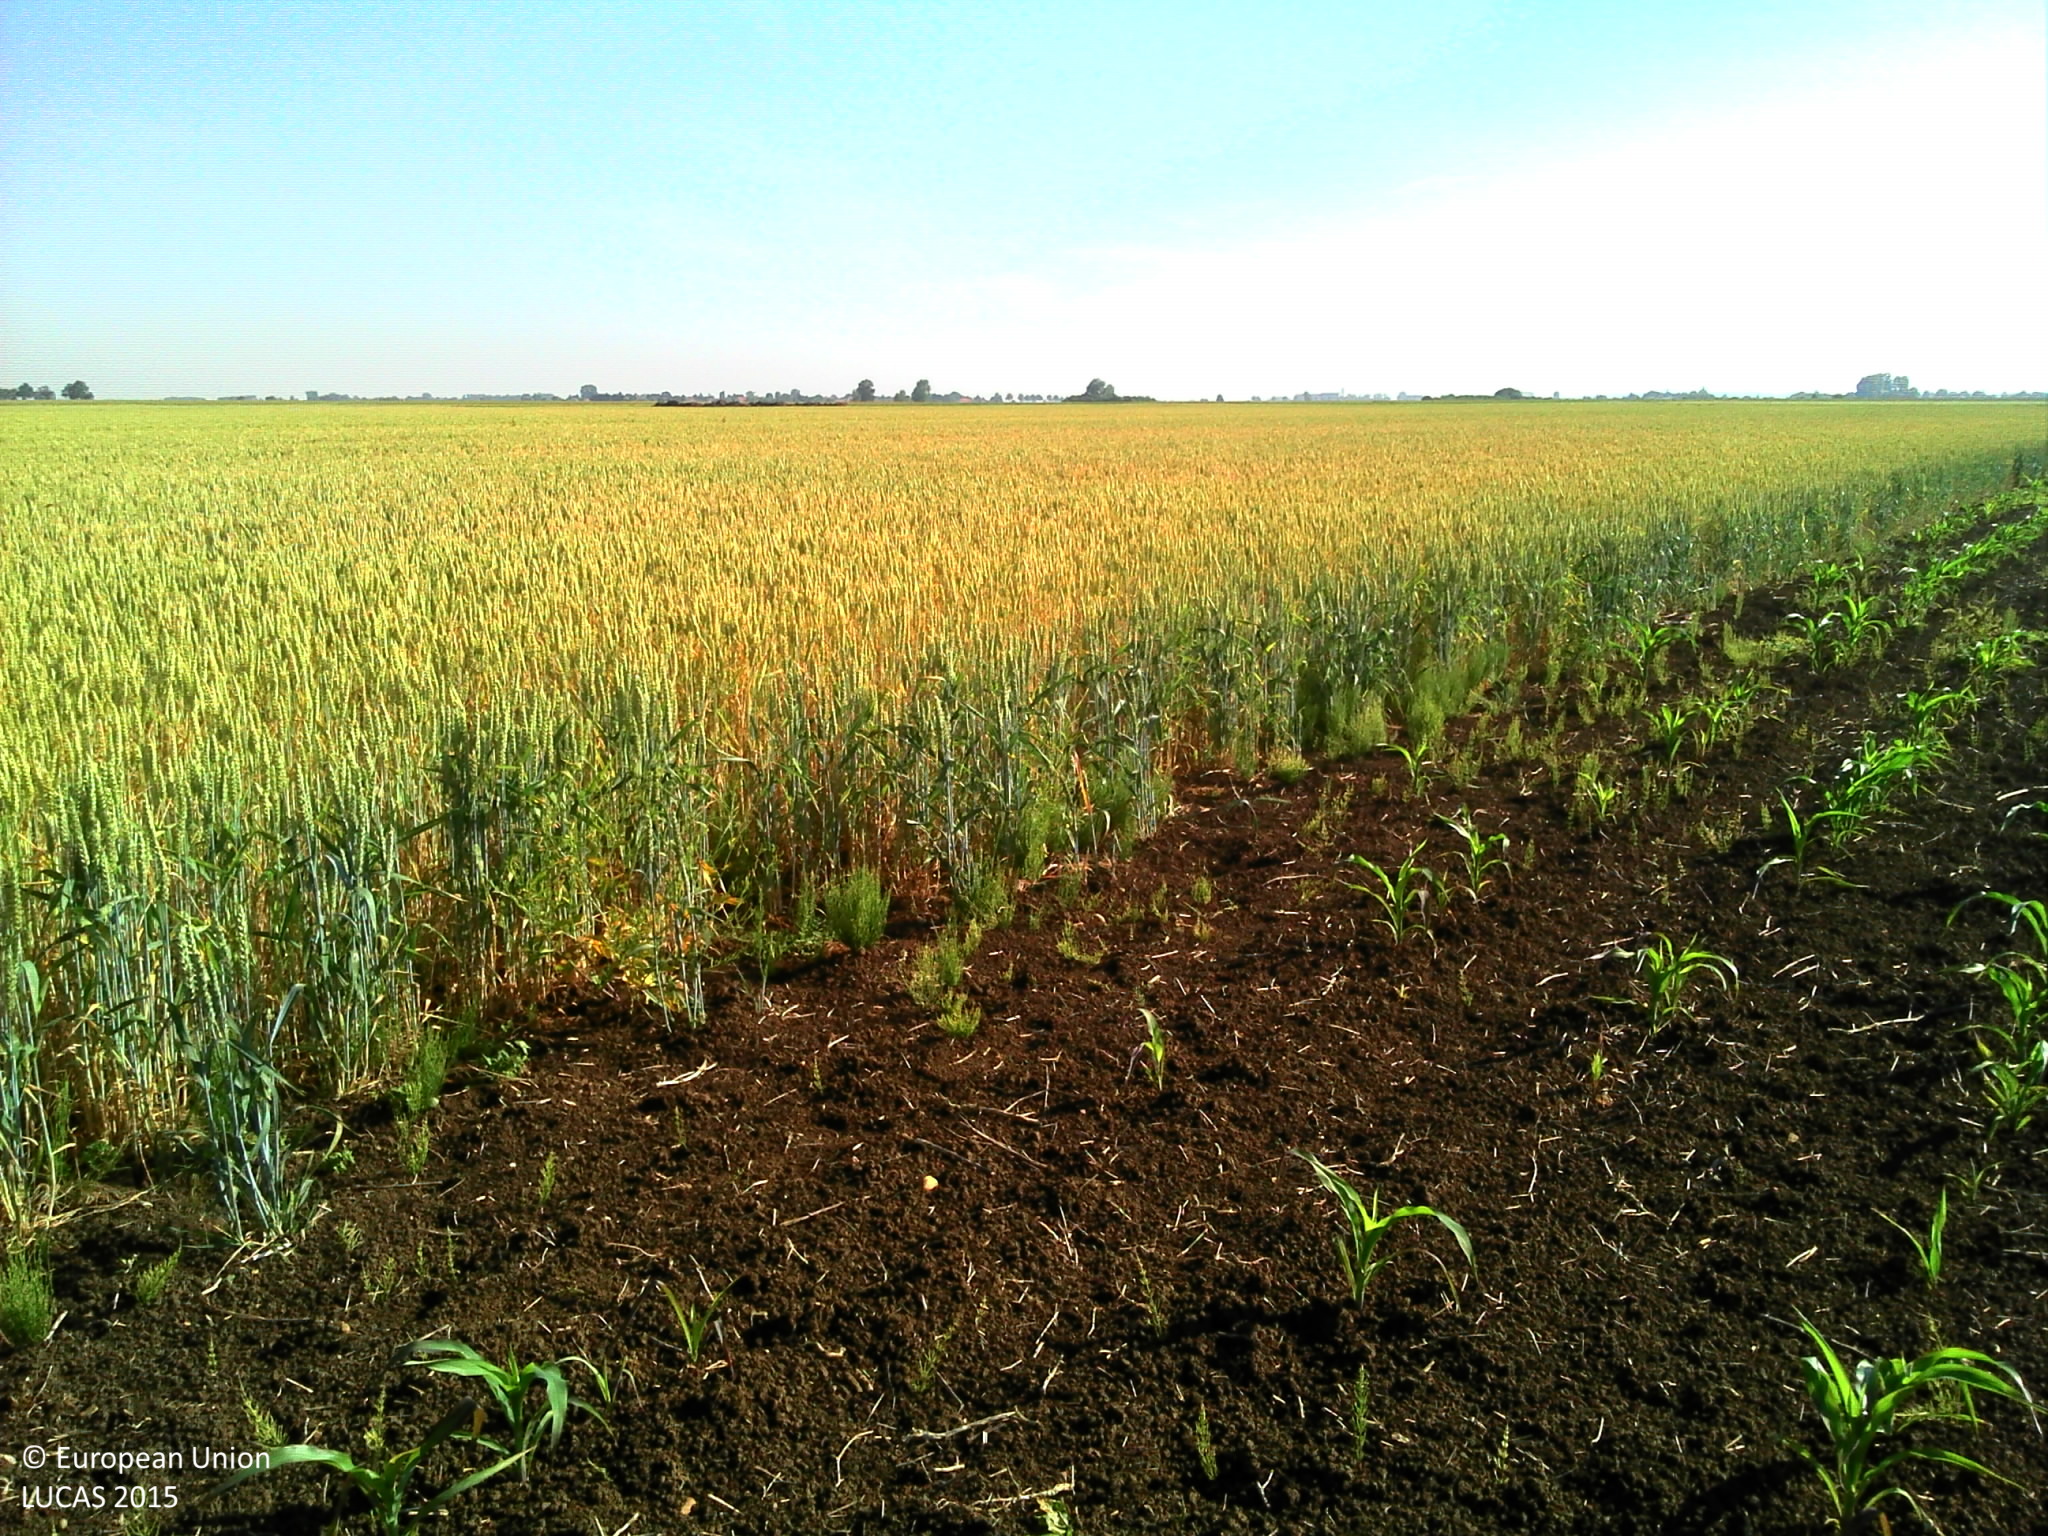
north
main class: Cropland
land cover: Maize
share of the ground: 25 - 50 %
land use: Agriculture (excluding fallow land and kitchen gardens)
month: June
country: FR
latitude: 46.9519
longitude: 5.3108
